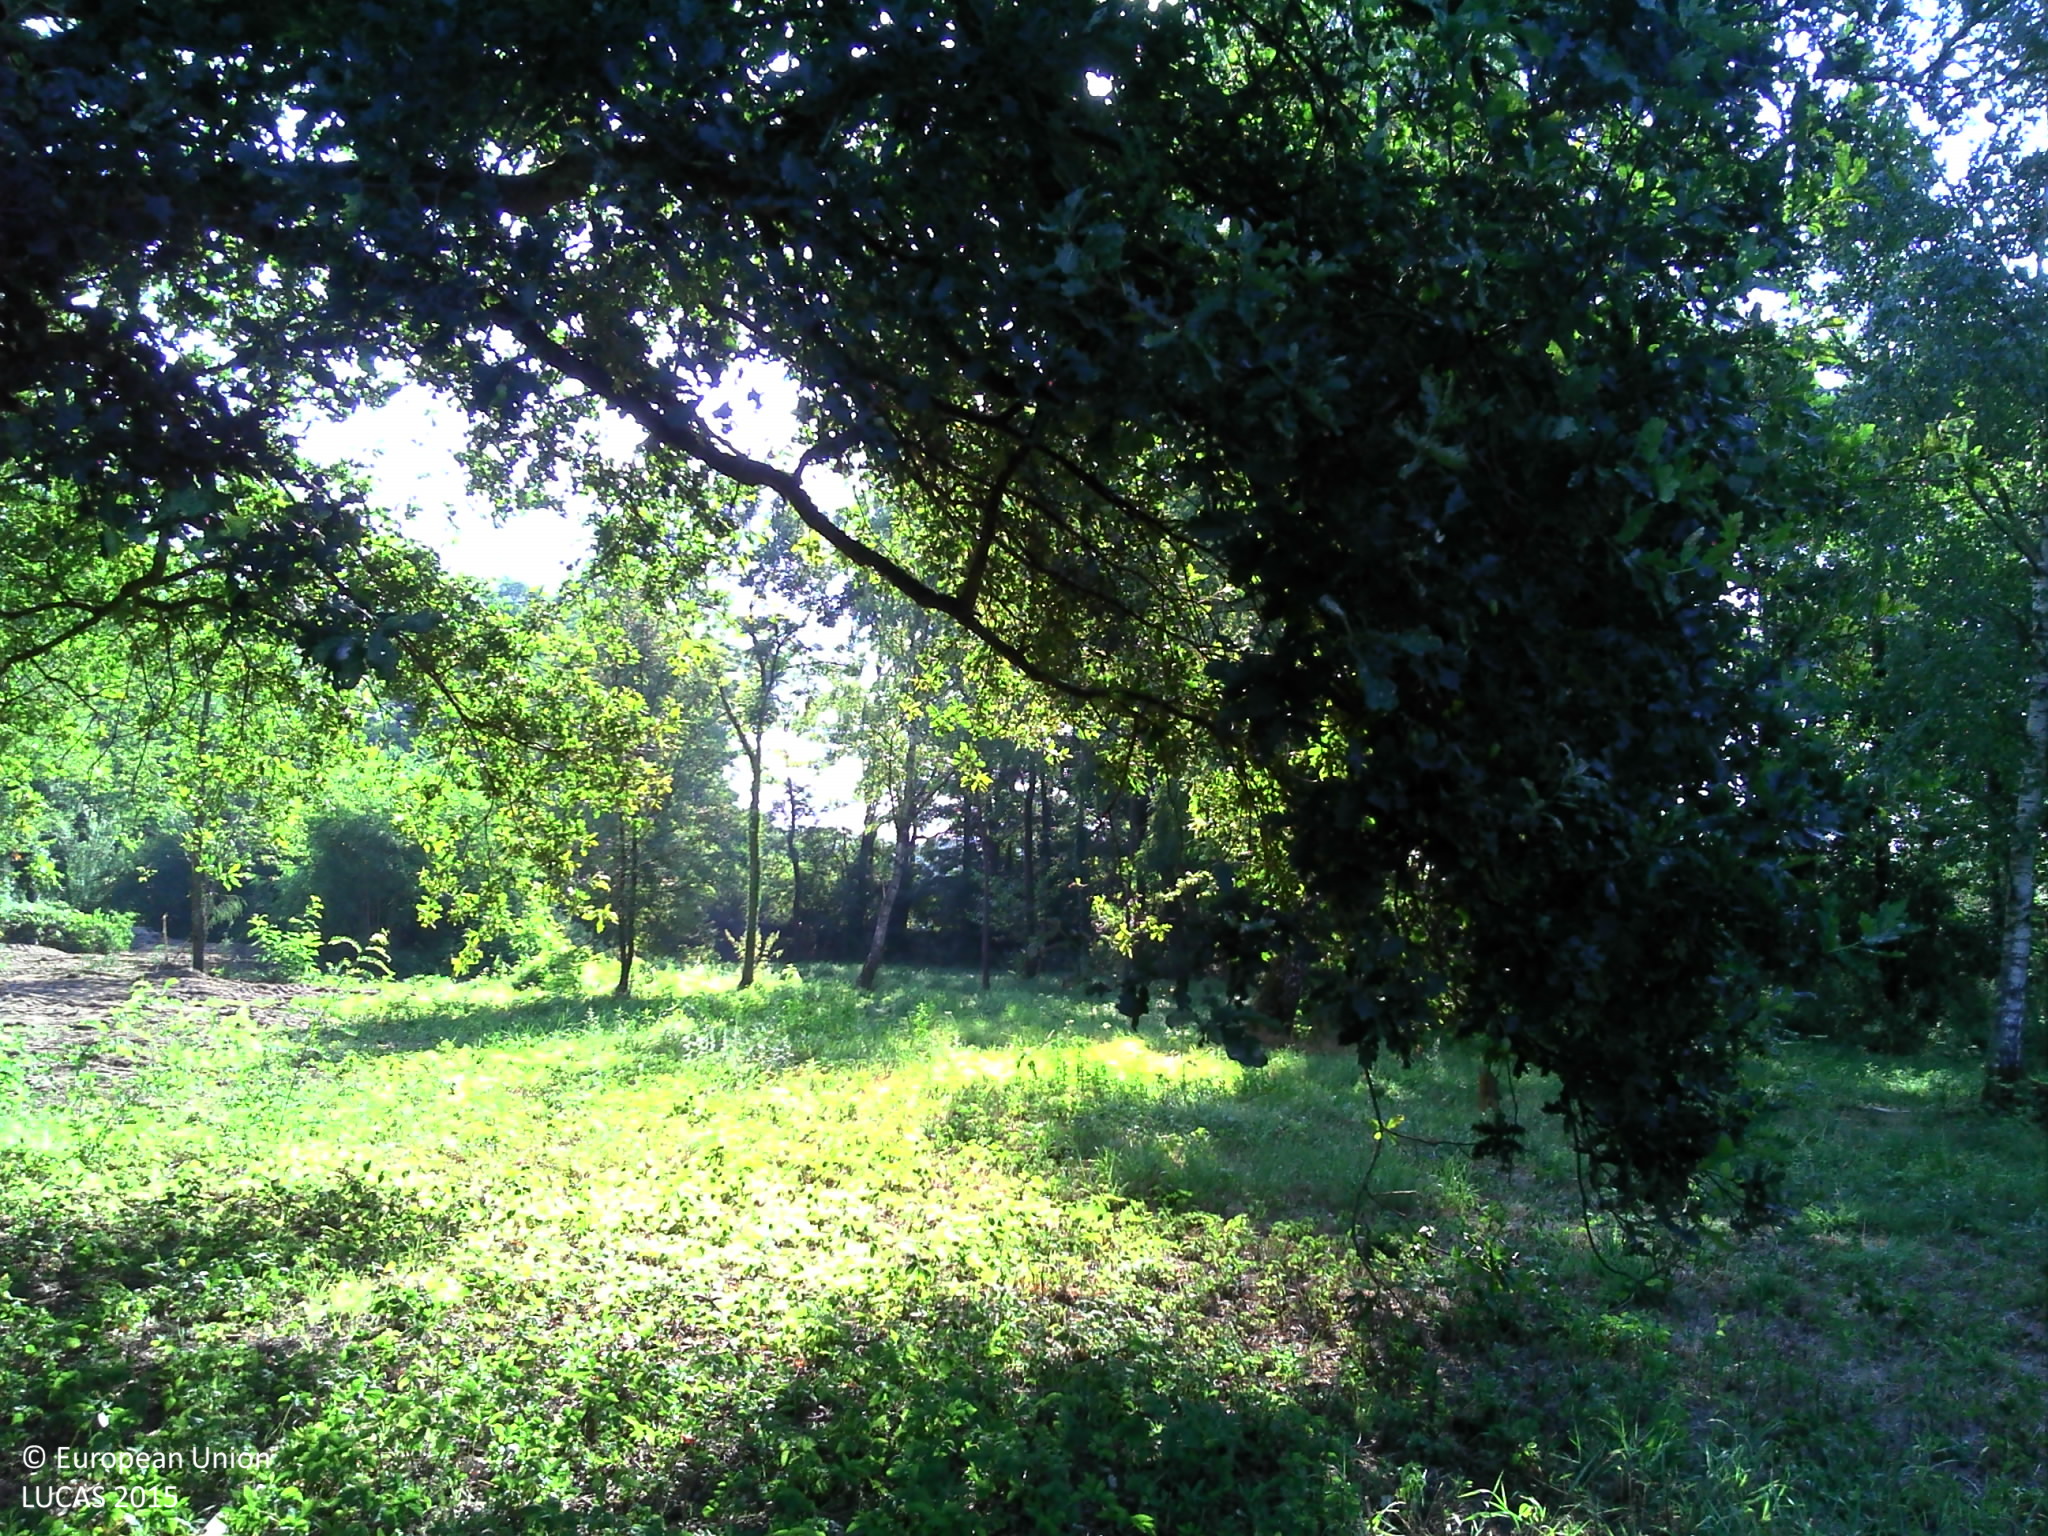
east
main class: Woodland
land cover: Broadleaved woodland
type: mesophytic deciduous forest
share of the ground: > 75 %
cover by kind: broadleaved forest trees 50 %, herbaceous plants 50 %
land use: Forestry
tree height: > 5 m
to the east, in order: Broadleaved woodland; Grassland without tree/shrub cover; Abandoned hedges; Other fresh vegetables; Grassland without tree/shrub cover; Common wheat; Spontaneously vegetated surfaces; Fences; Broadleaved woodland; Spontaneously vegetated surfaces
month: August
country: FR
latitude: 48.8348
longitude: 7.9708
